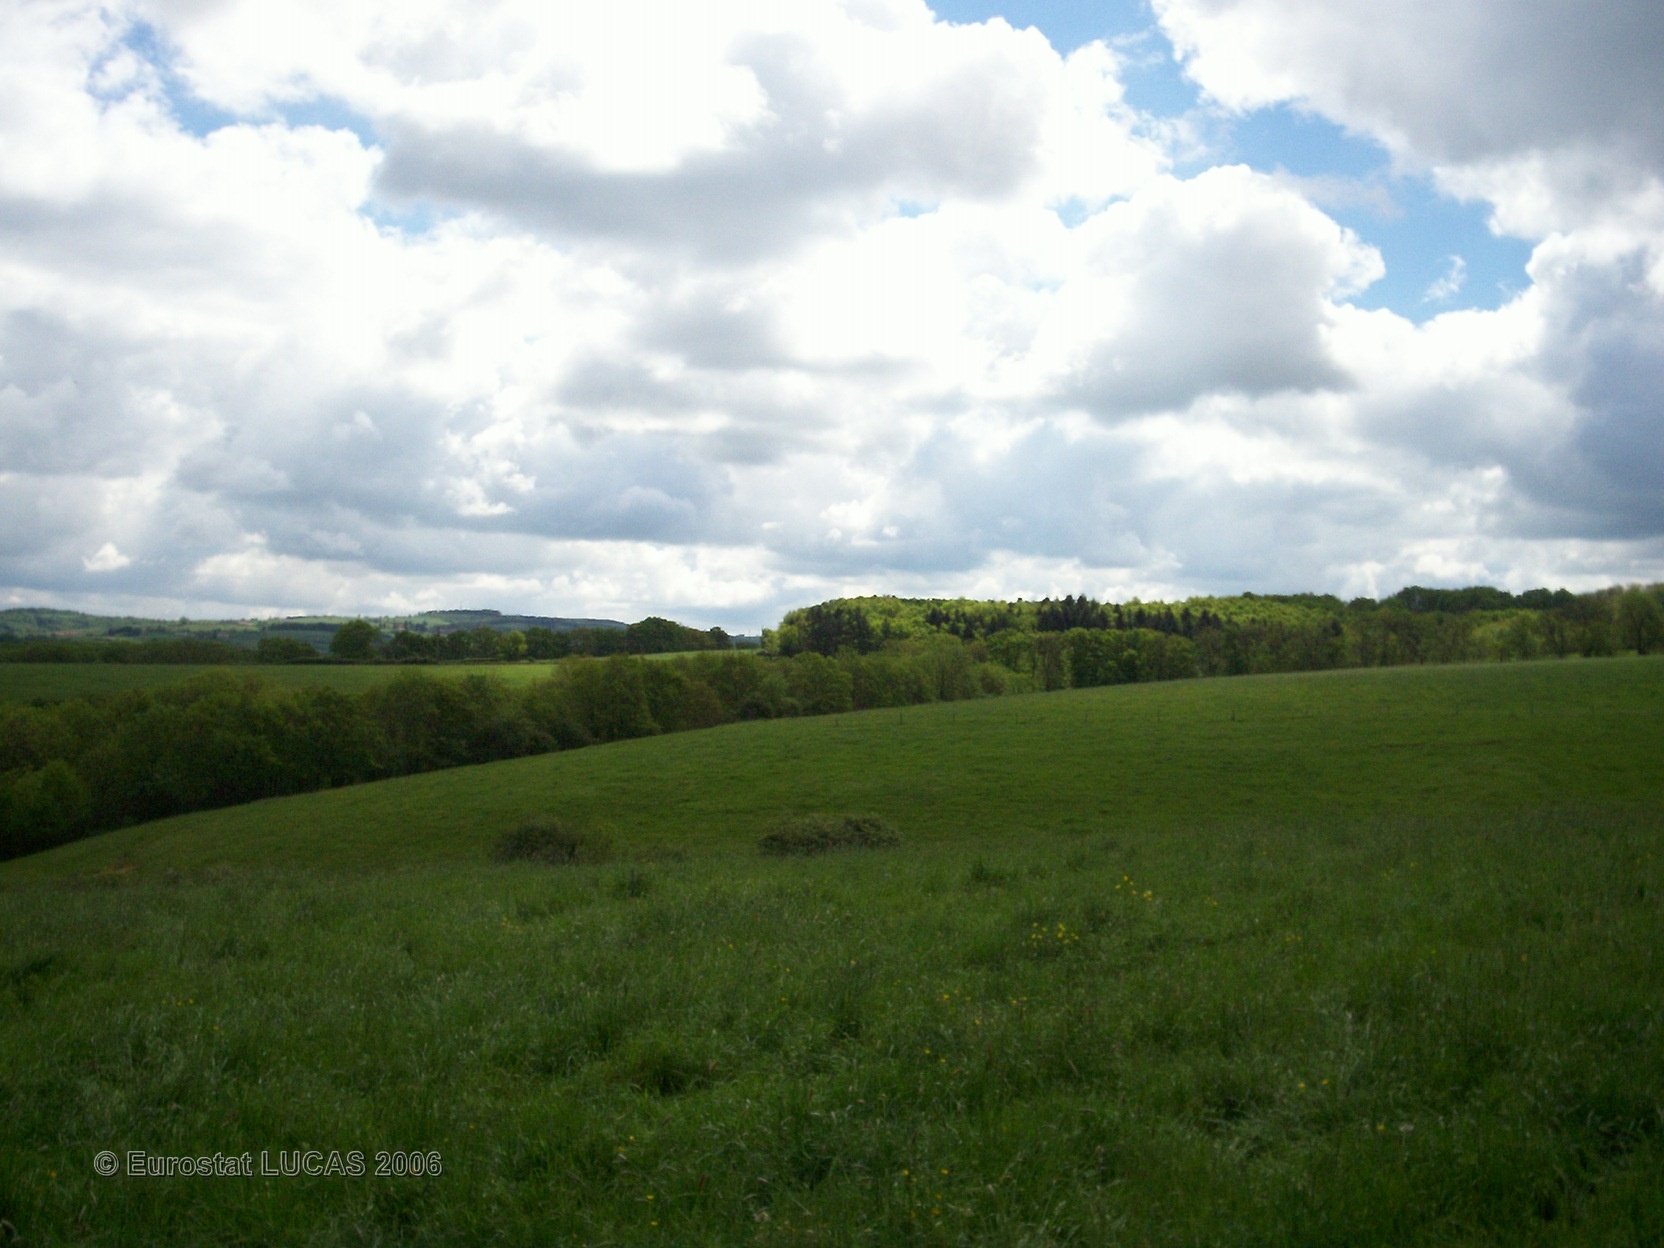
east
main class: Grassland
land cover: Grassland without tree/shrub cover
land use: Agriculture (excluding fallow land and kitchen gardens)
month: May
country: FR
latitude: 45.9539
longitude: 4.1058
